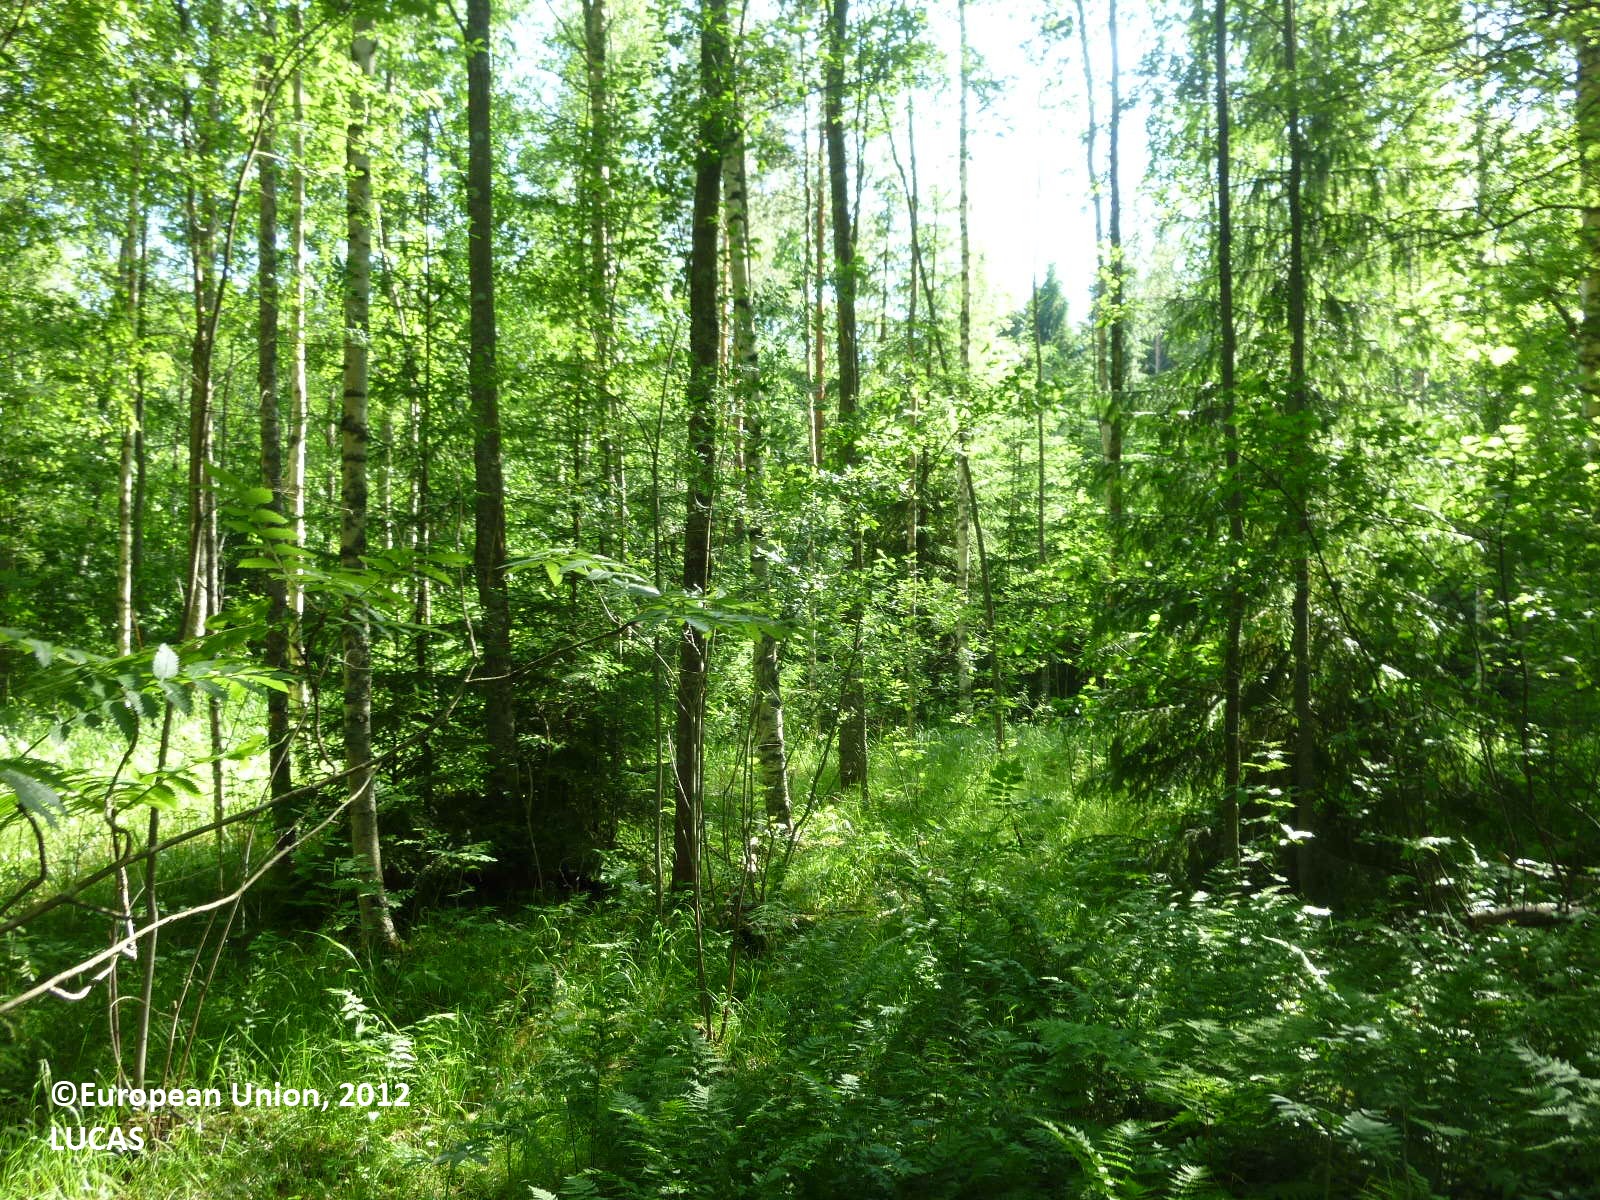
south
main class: Woodland
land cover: Broadleaved woodland
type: boreal forest
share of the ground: > 75 %
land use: Forestry
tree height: > 5 m
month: July
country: FI
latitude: 61.3479
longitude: 21.9662
